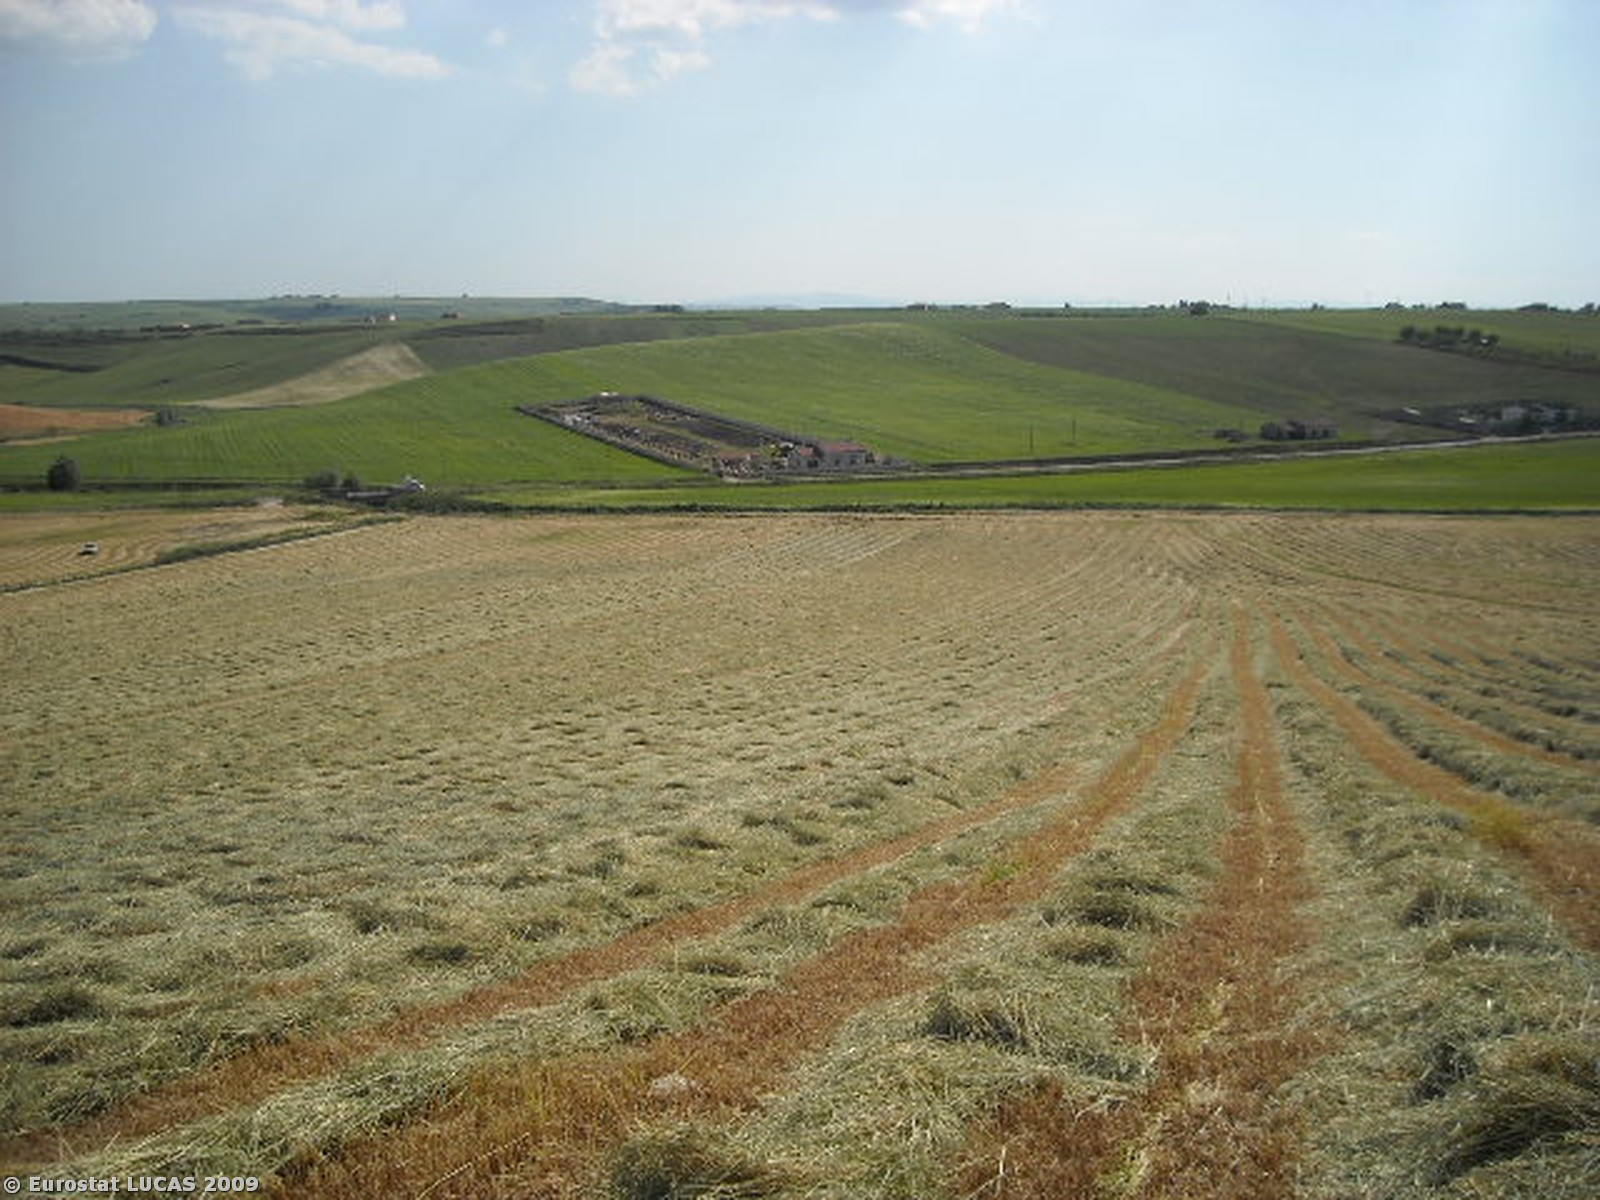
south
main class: Cropland
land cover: Mixed cereals for fodder
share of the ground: > 75 %
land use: Agriculture (excluding fallow land and kitchen gardens)
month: May
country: IT
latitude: 40.8614
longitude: 16.3252
